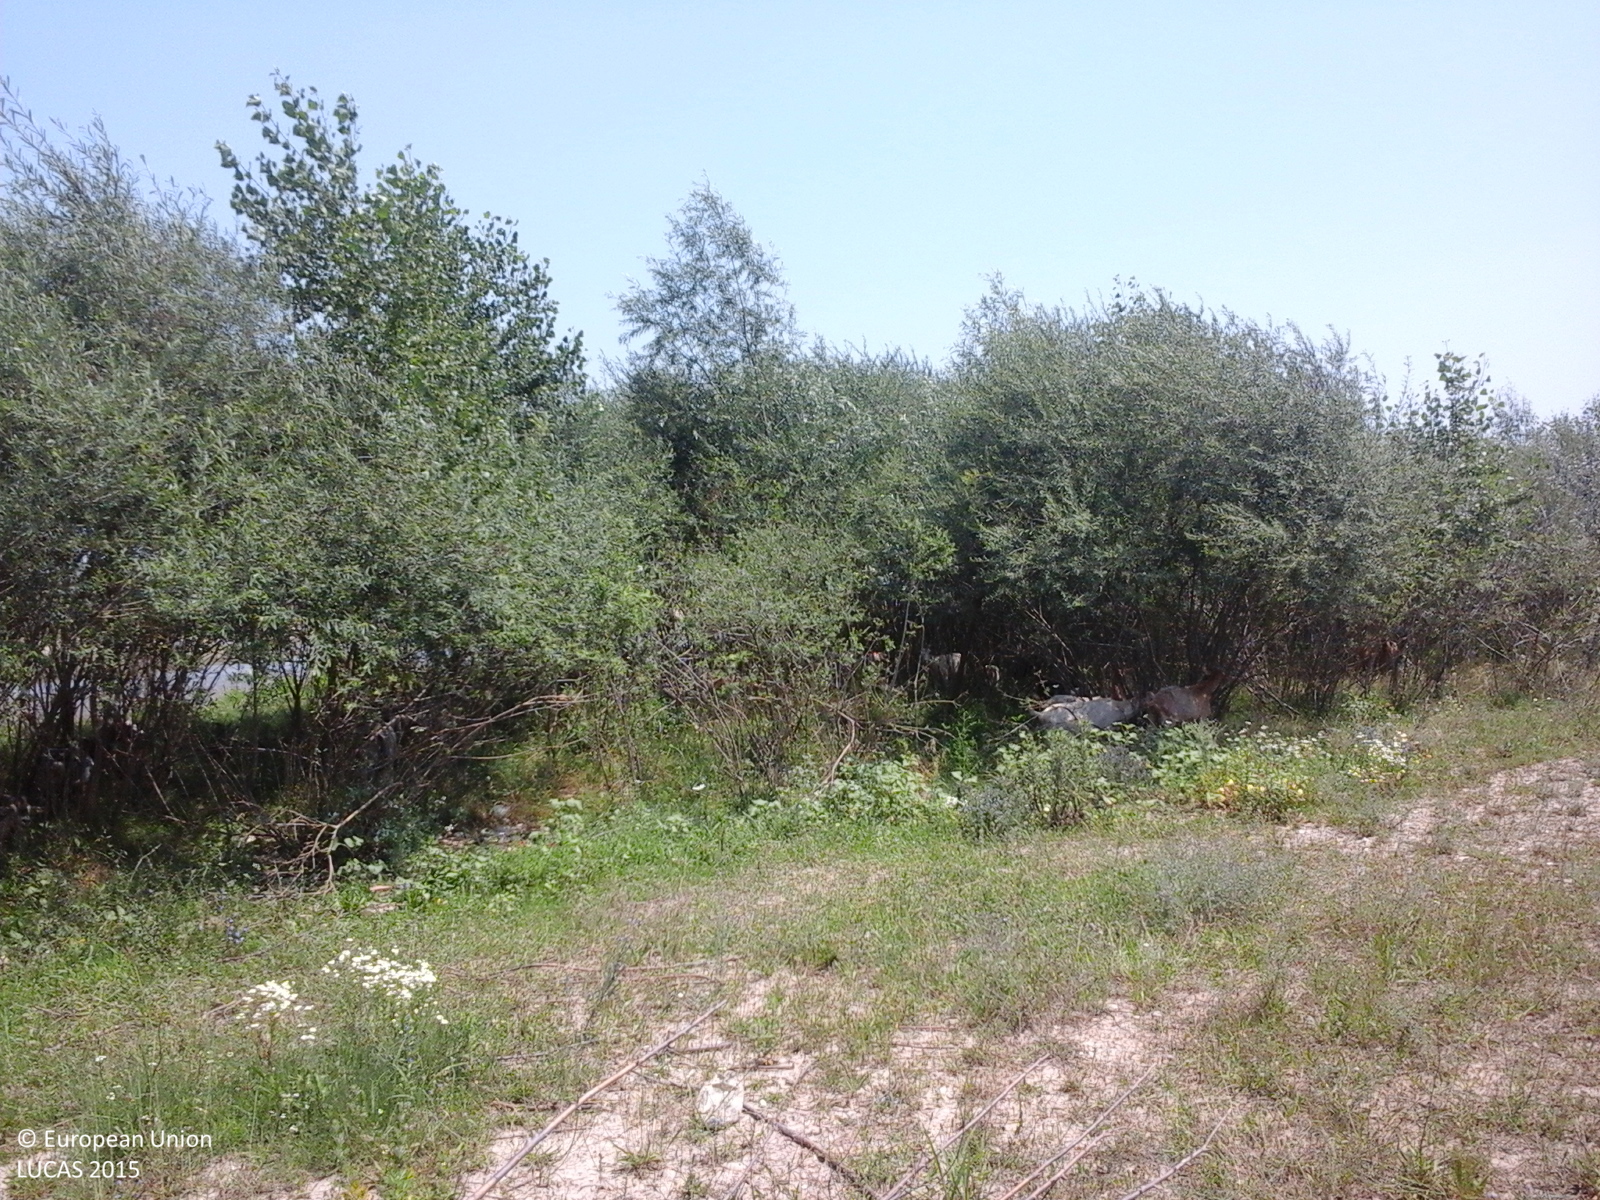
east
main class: Grassland
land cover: Spontaneously vegetated surfaces
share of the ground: 10 - 25 %
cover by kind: herbaceous plants 100 %
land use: Agriculture (excluding fallow land and kitchen gardens)
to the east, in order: Spontaneously vegetated surfaces; Broadleaved woodland; Inland fresh running water; Broadleaved woodland
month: July
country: RO
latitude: 44.7921
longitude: 25.7359
